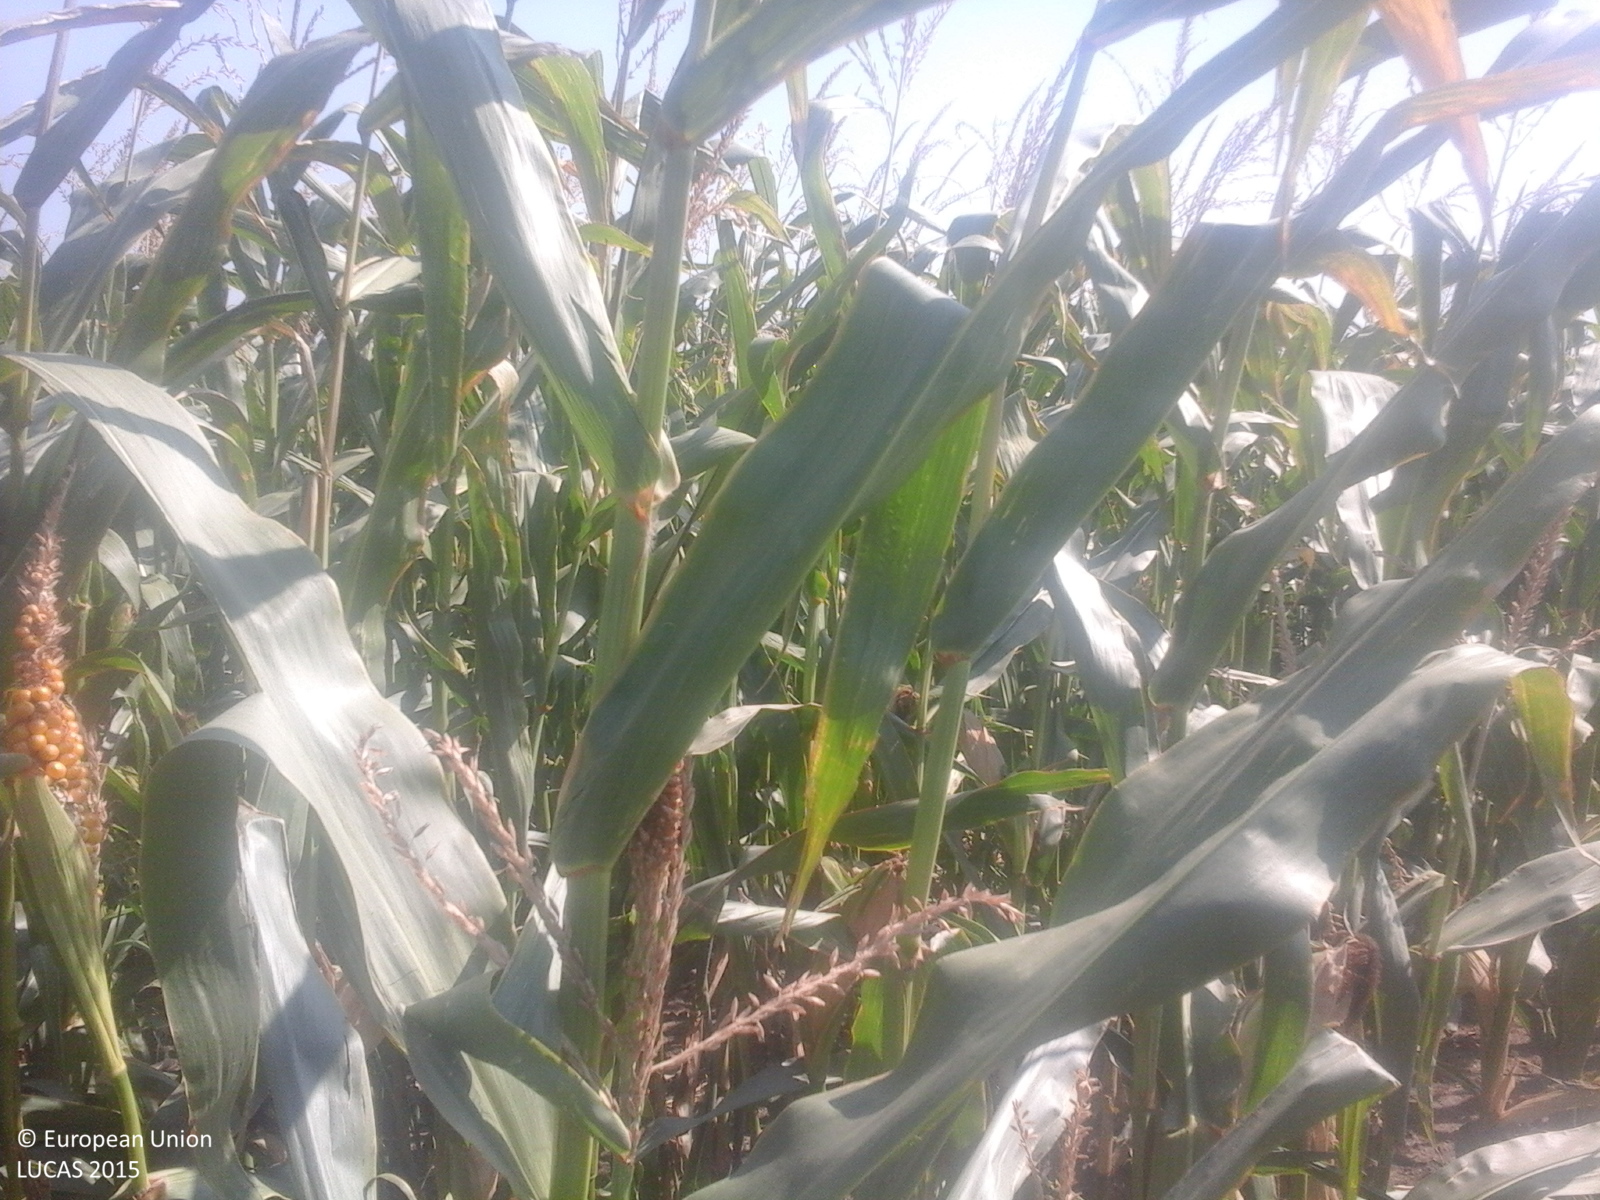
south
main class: Cropland
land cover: Maize
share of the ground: > 75 %
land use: Agriculture (excluding fallow land and kitchen gardens)
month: August
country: RO
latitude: 45.2196
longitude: 27.5344
